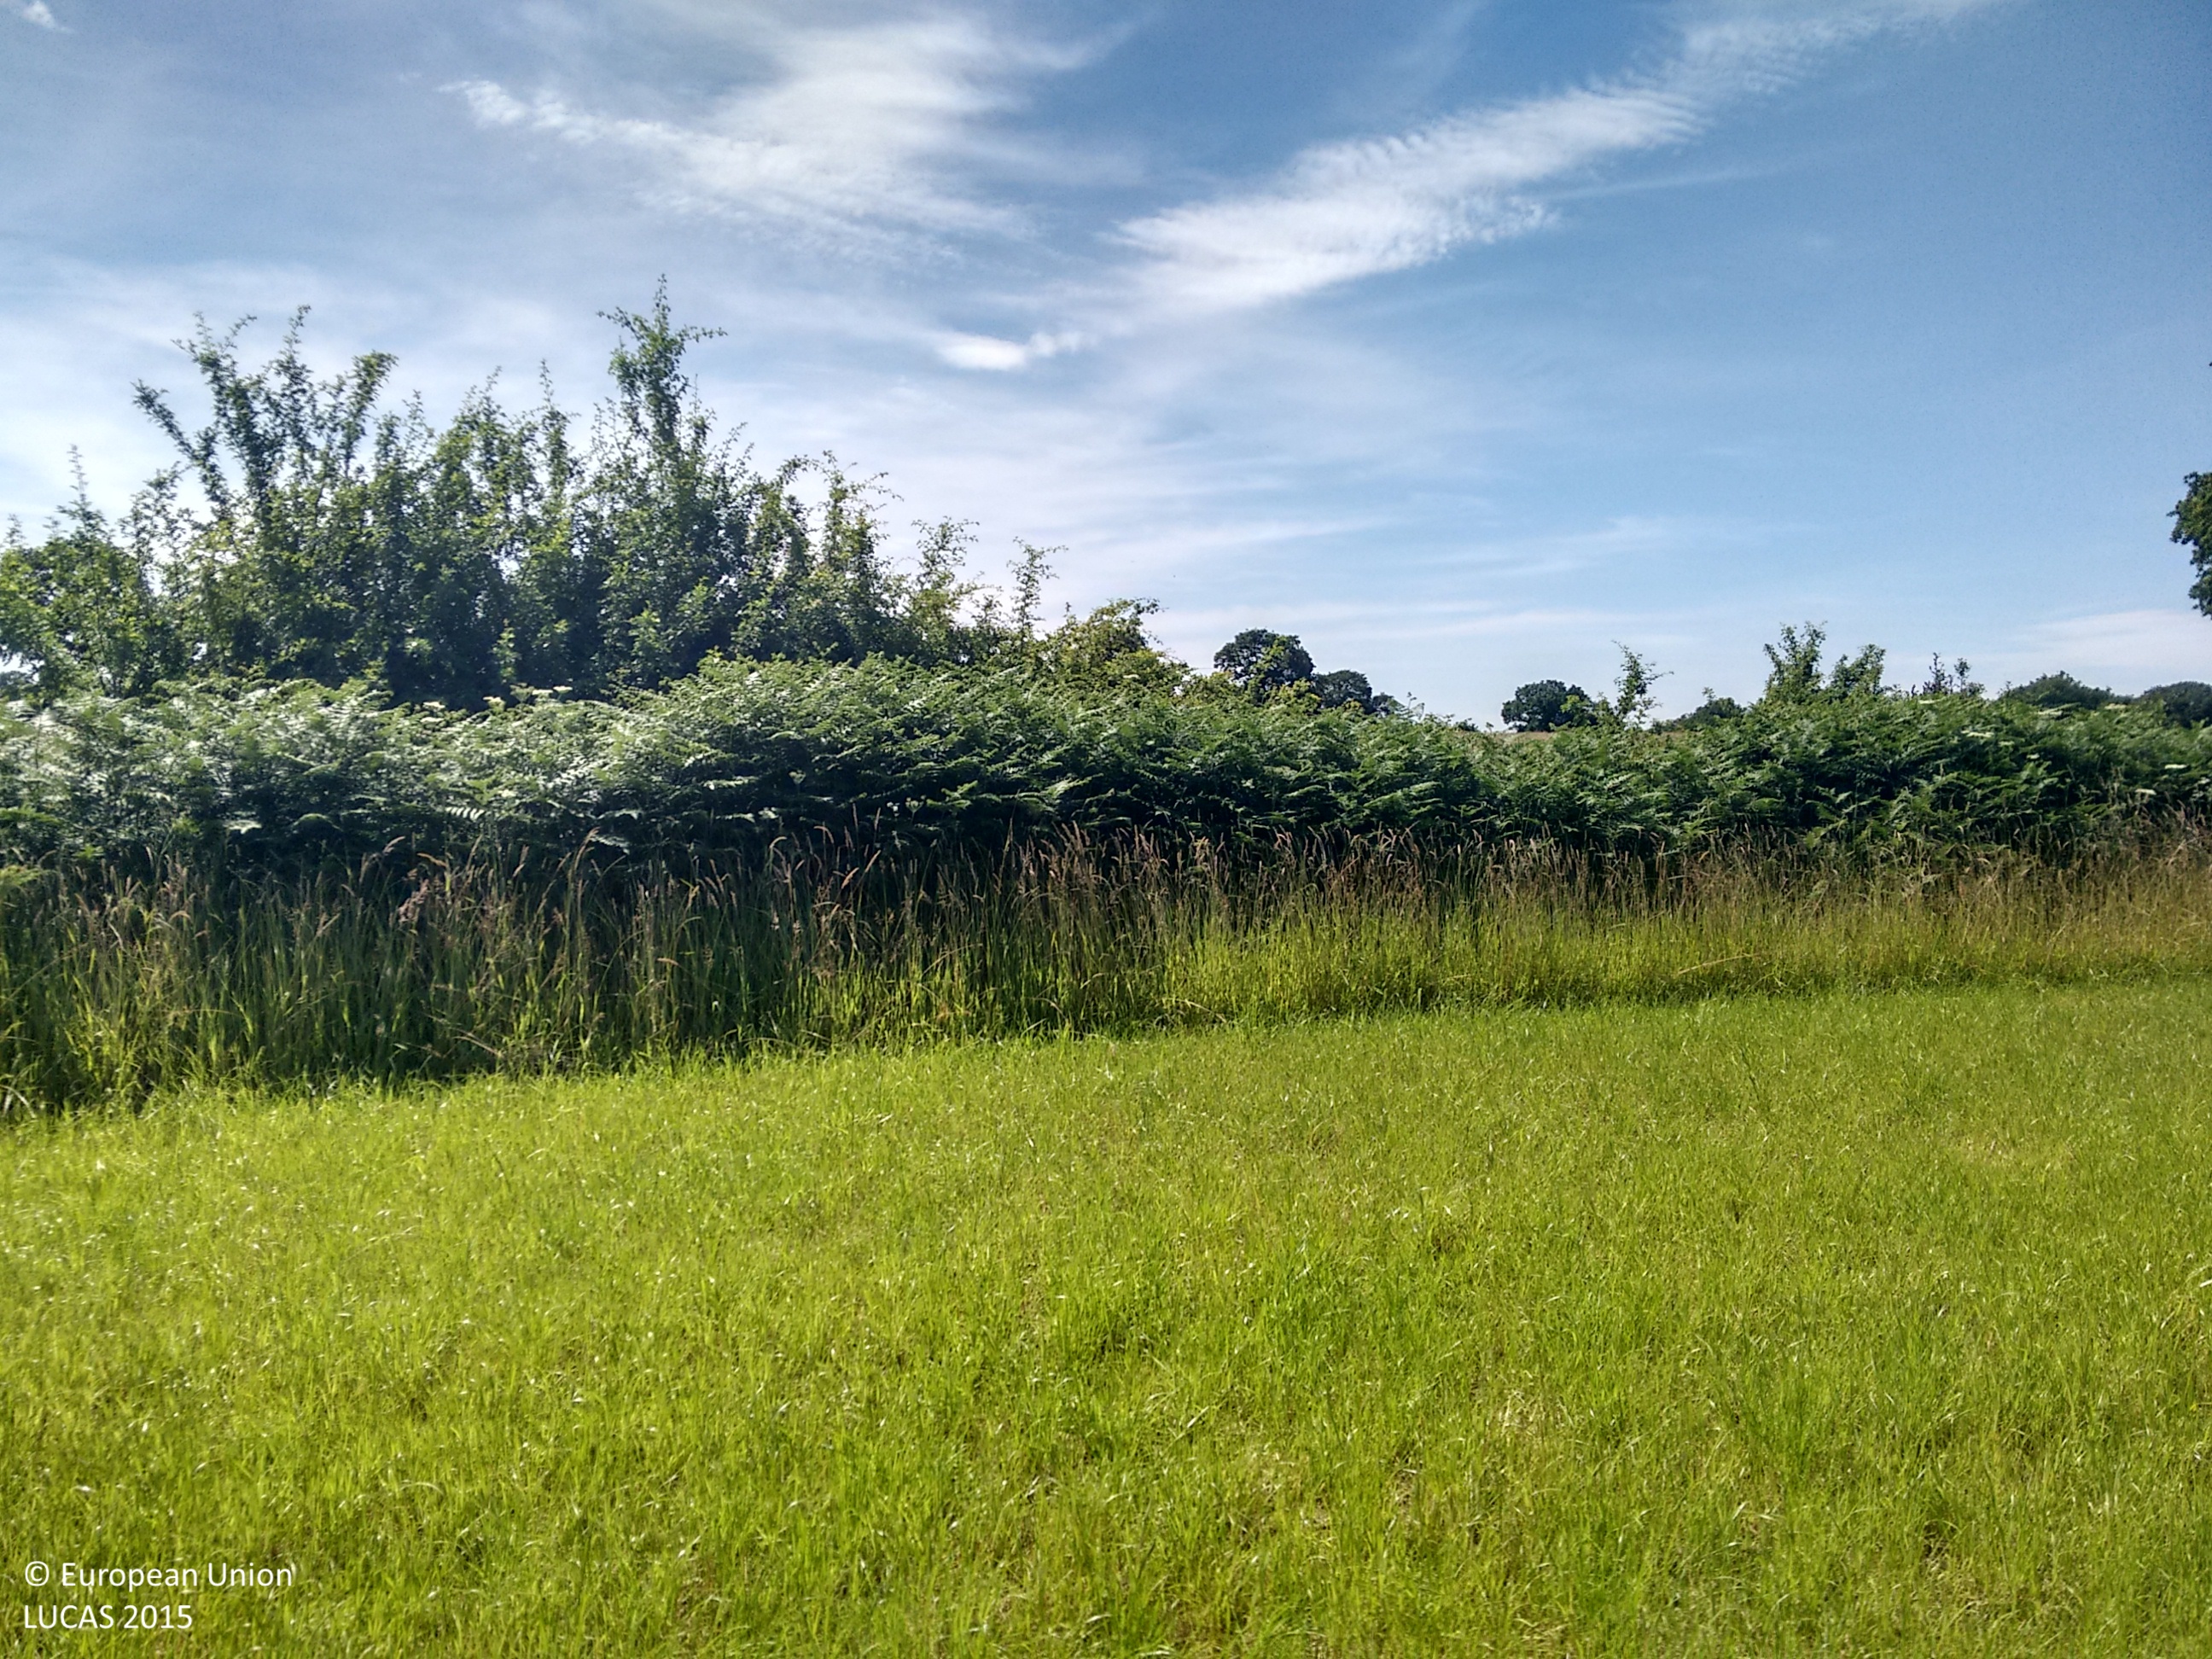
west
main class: Cropland
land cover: Temporary grasslands
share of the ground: > 75 %
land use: Agriculture (excluding fallow land and kitchen gardens)
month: July
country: GB
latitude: 53.3321
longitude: -2.5143
